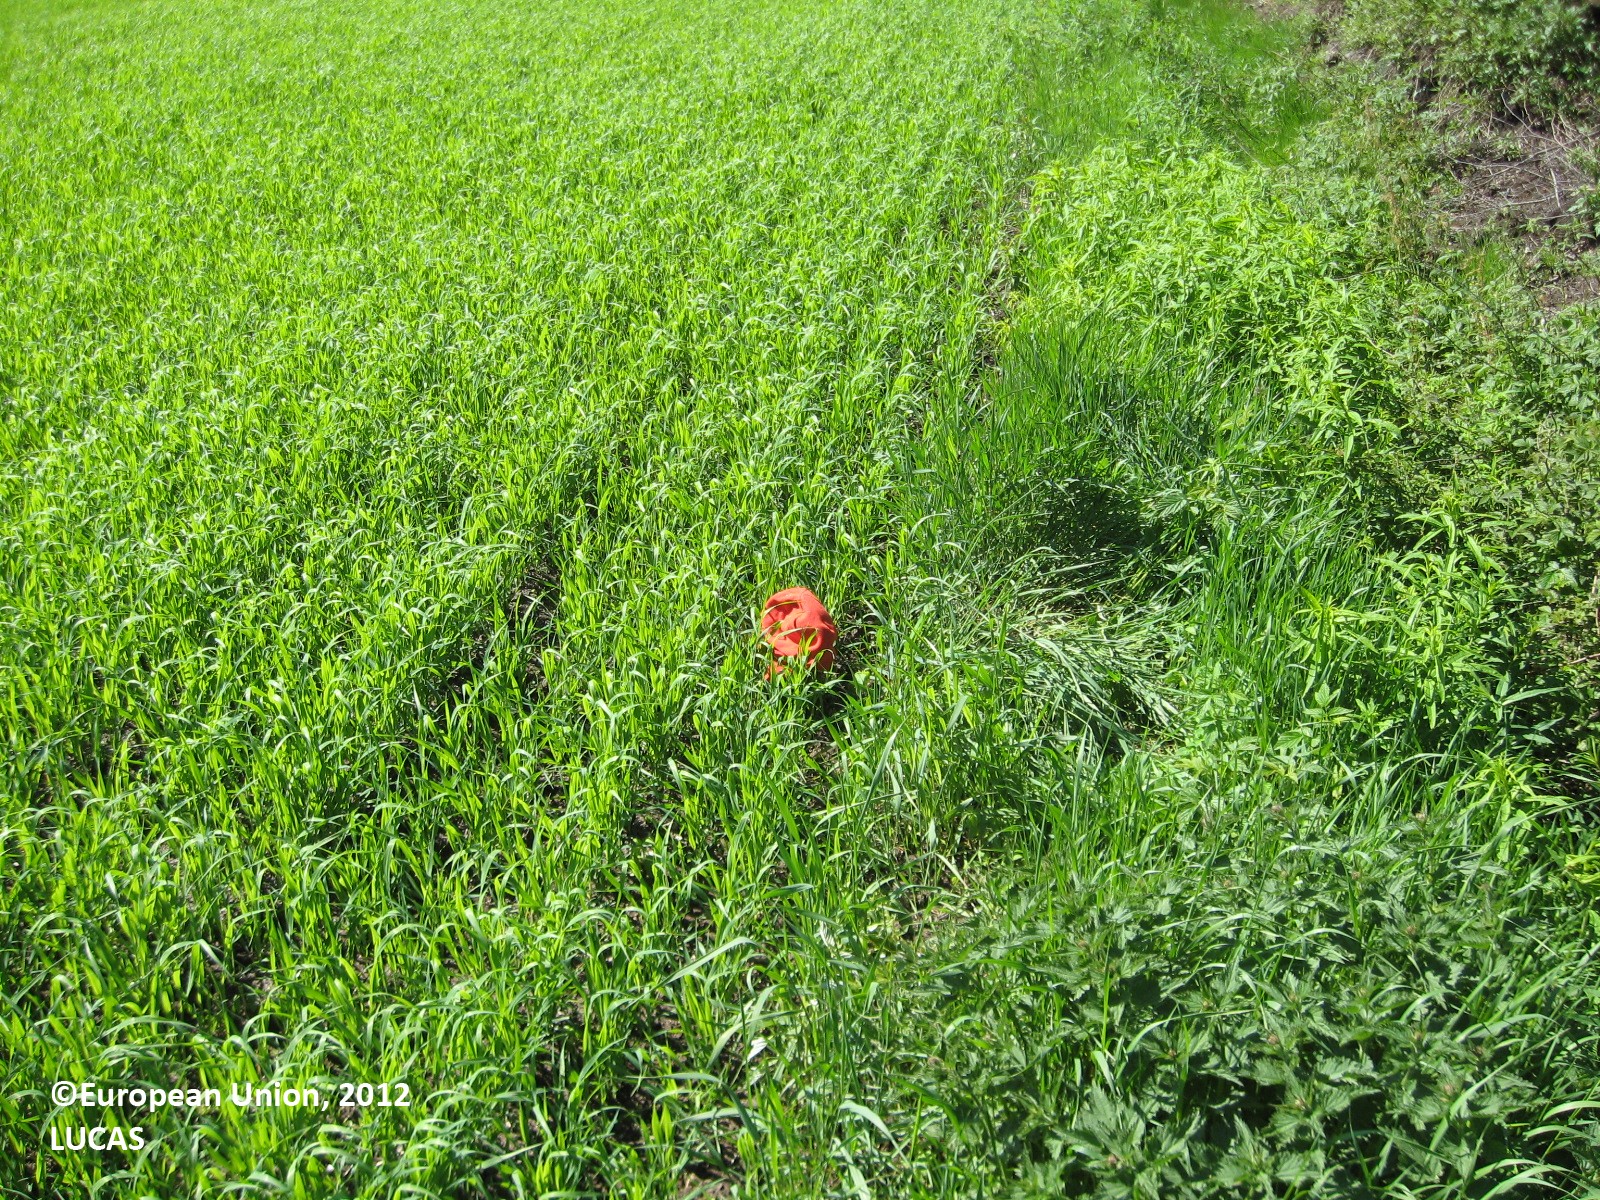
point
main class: Cropland
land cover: Oats
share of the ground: > 75 %
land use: Agriculture (excluding fallow land and kitchen gardens)
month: June
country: FI
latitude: 62.9441
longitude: 21.6484
